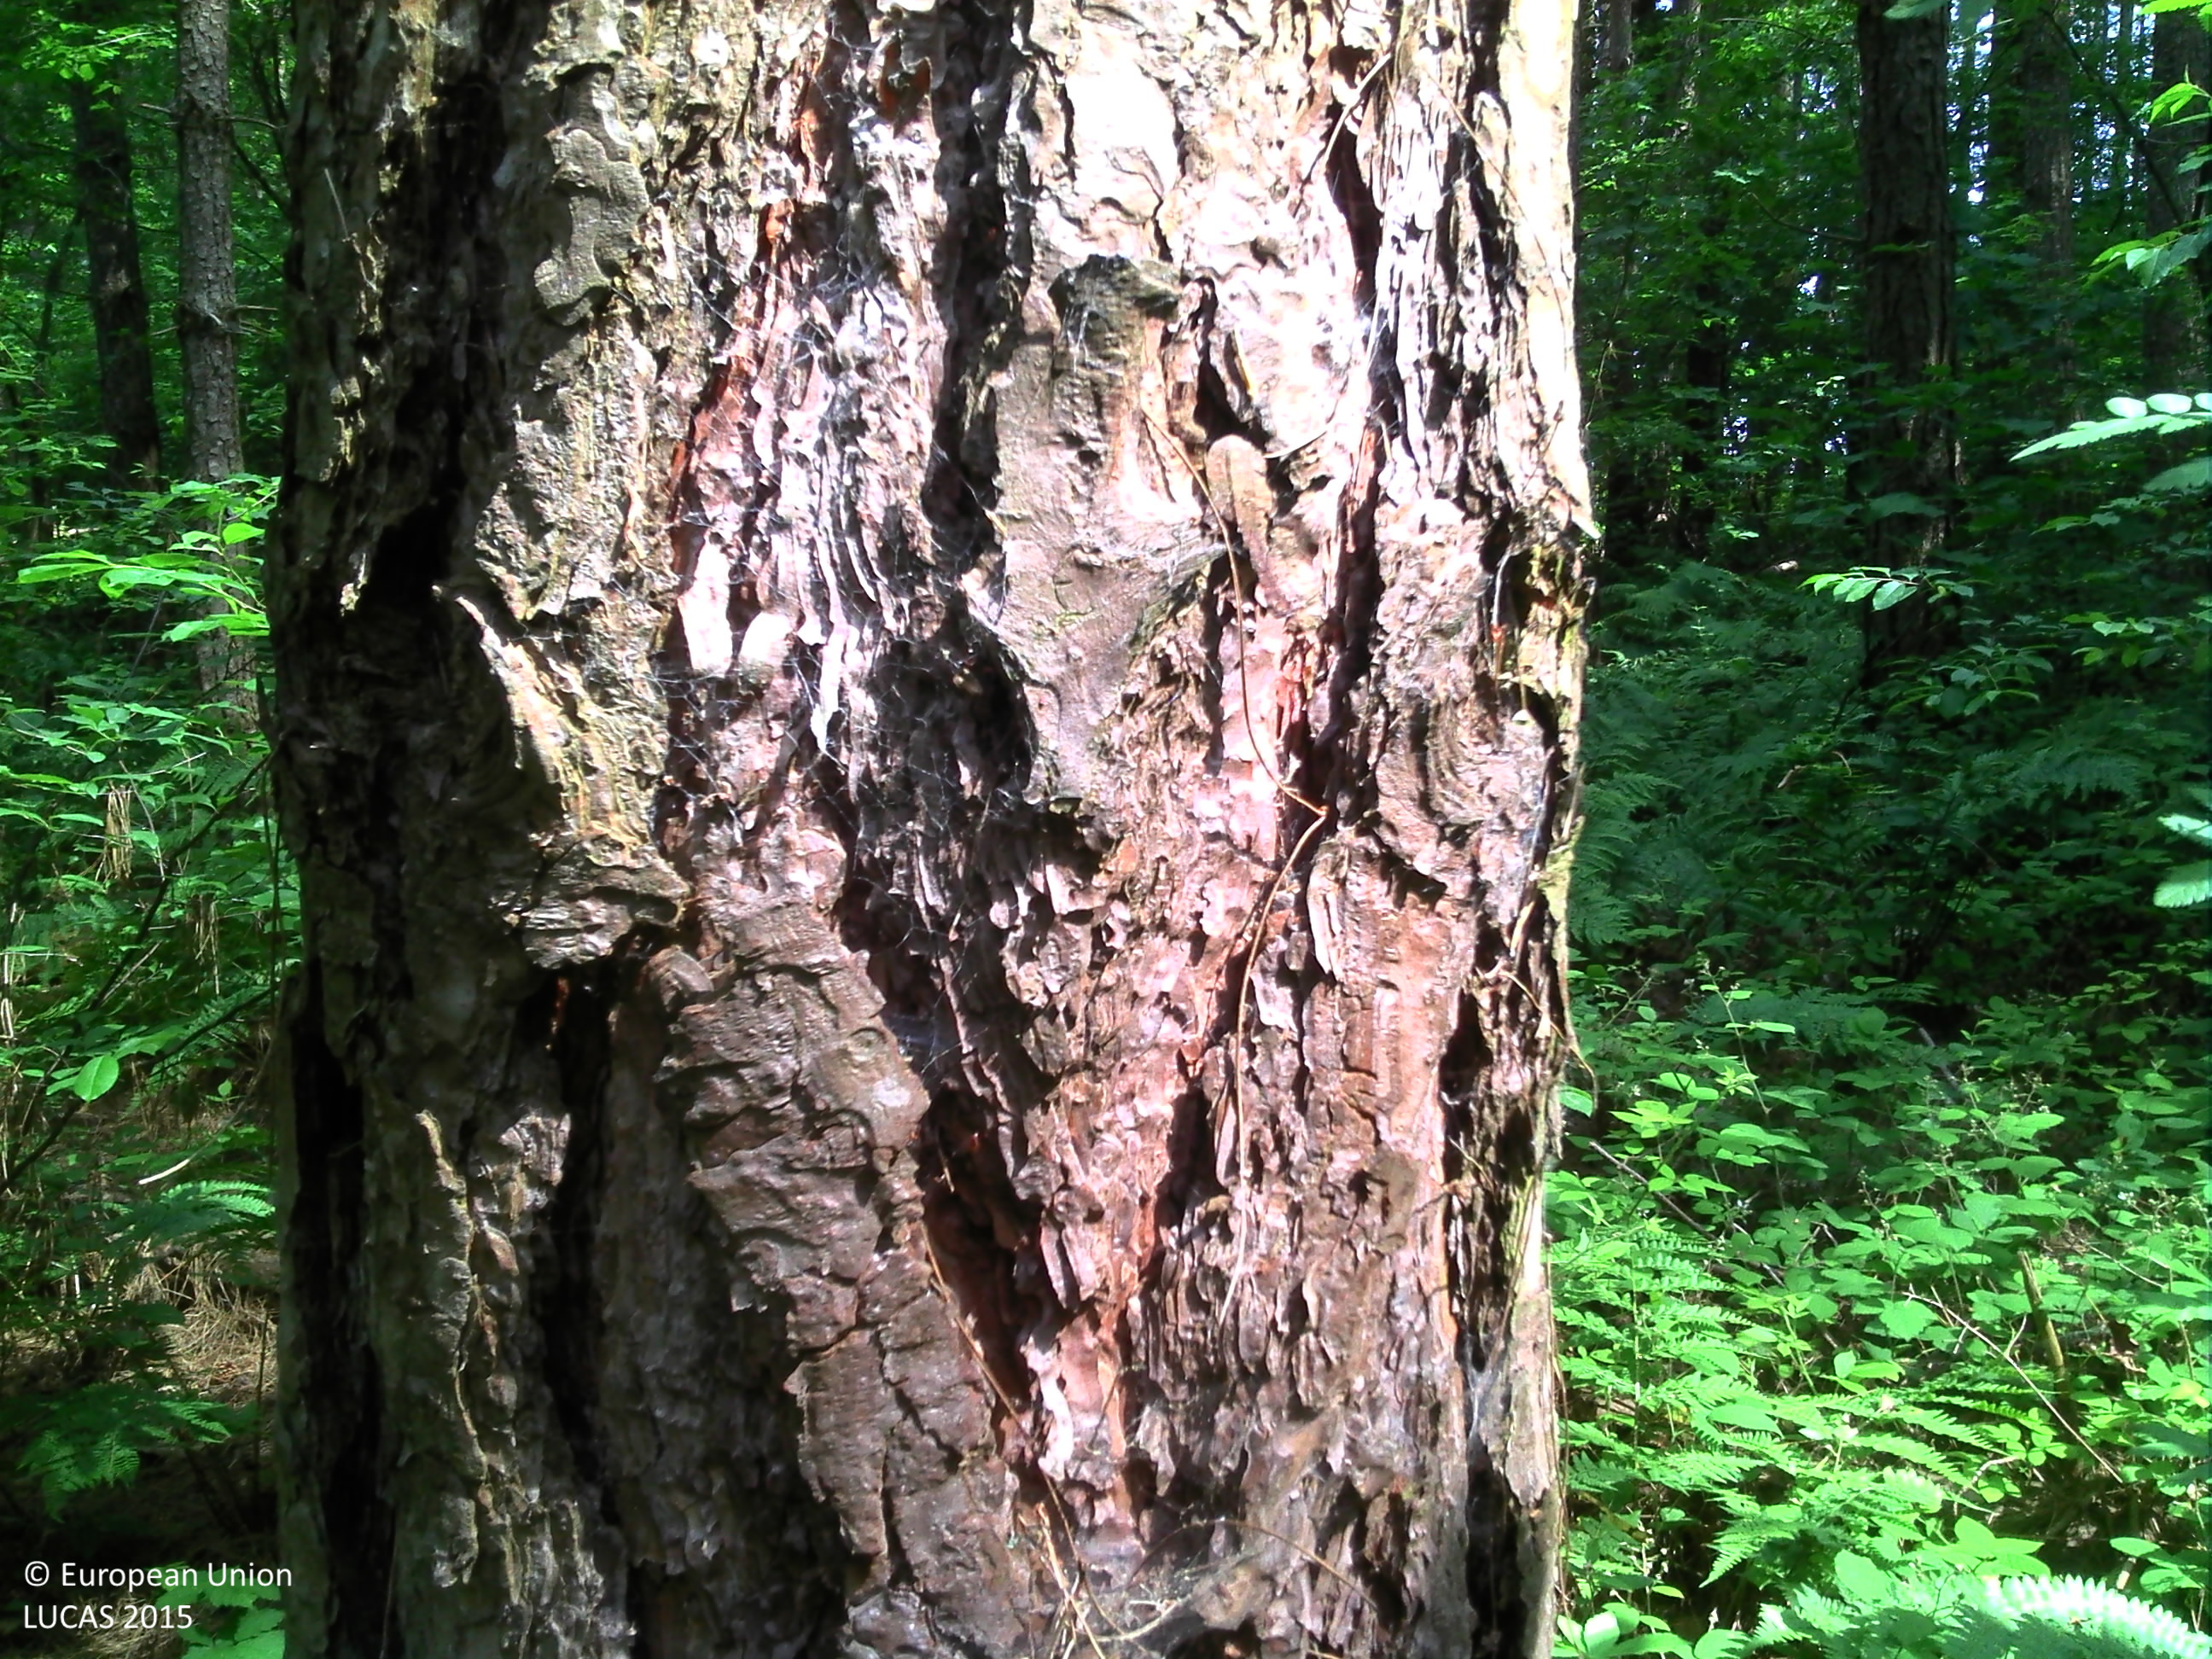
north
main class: Woodland
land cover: Pine dominated mixed woodland
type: exotic forest
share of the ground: > 75 %
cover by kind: coniferous forest trees 75 %, broadleaved forest trees 25 %
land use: Forestry
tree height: > 5 m
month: June
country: BE
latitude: 51.0303
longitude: 5.0207
